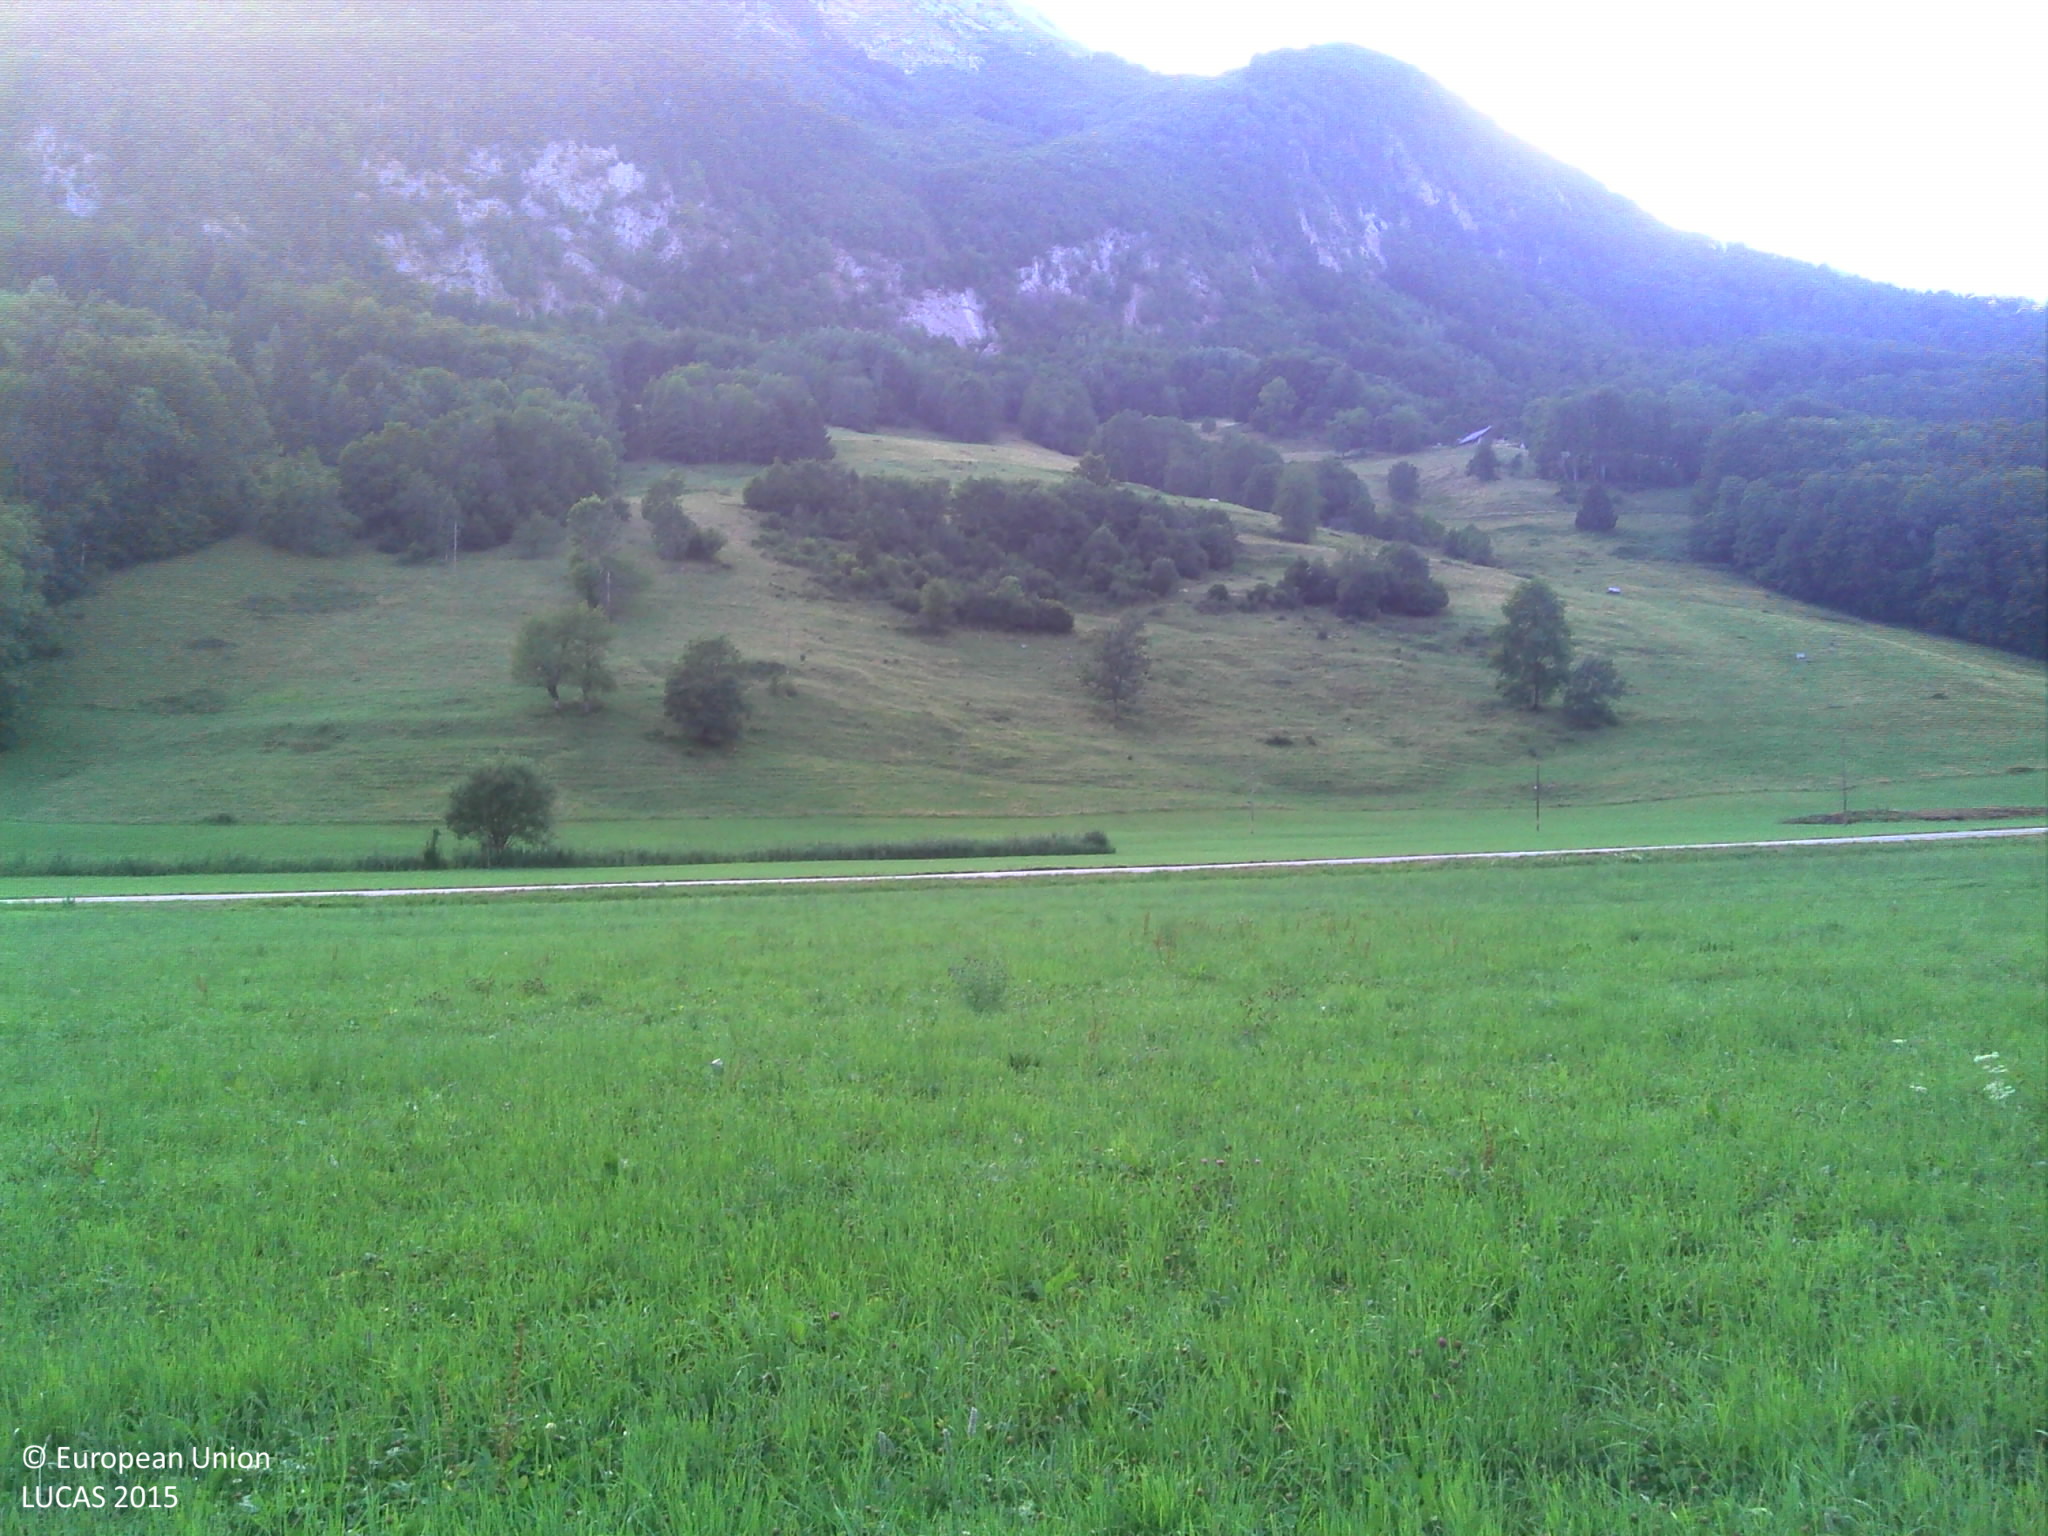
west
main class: Grassland
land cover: Grassland without tree/shrub cover
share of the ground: > 75 %
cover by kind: herbaceous plants 100 %
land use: Agriculture (excluding fallow land and kitchen gardens)
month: July
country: FR
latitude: 45.8196
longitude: 6.3360
